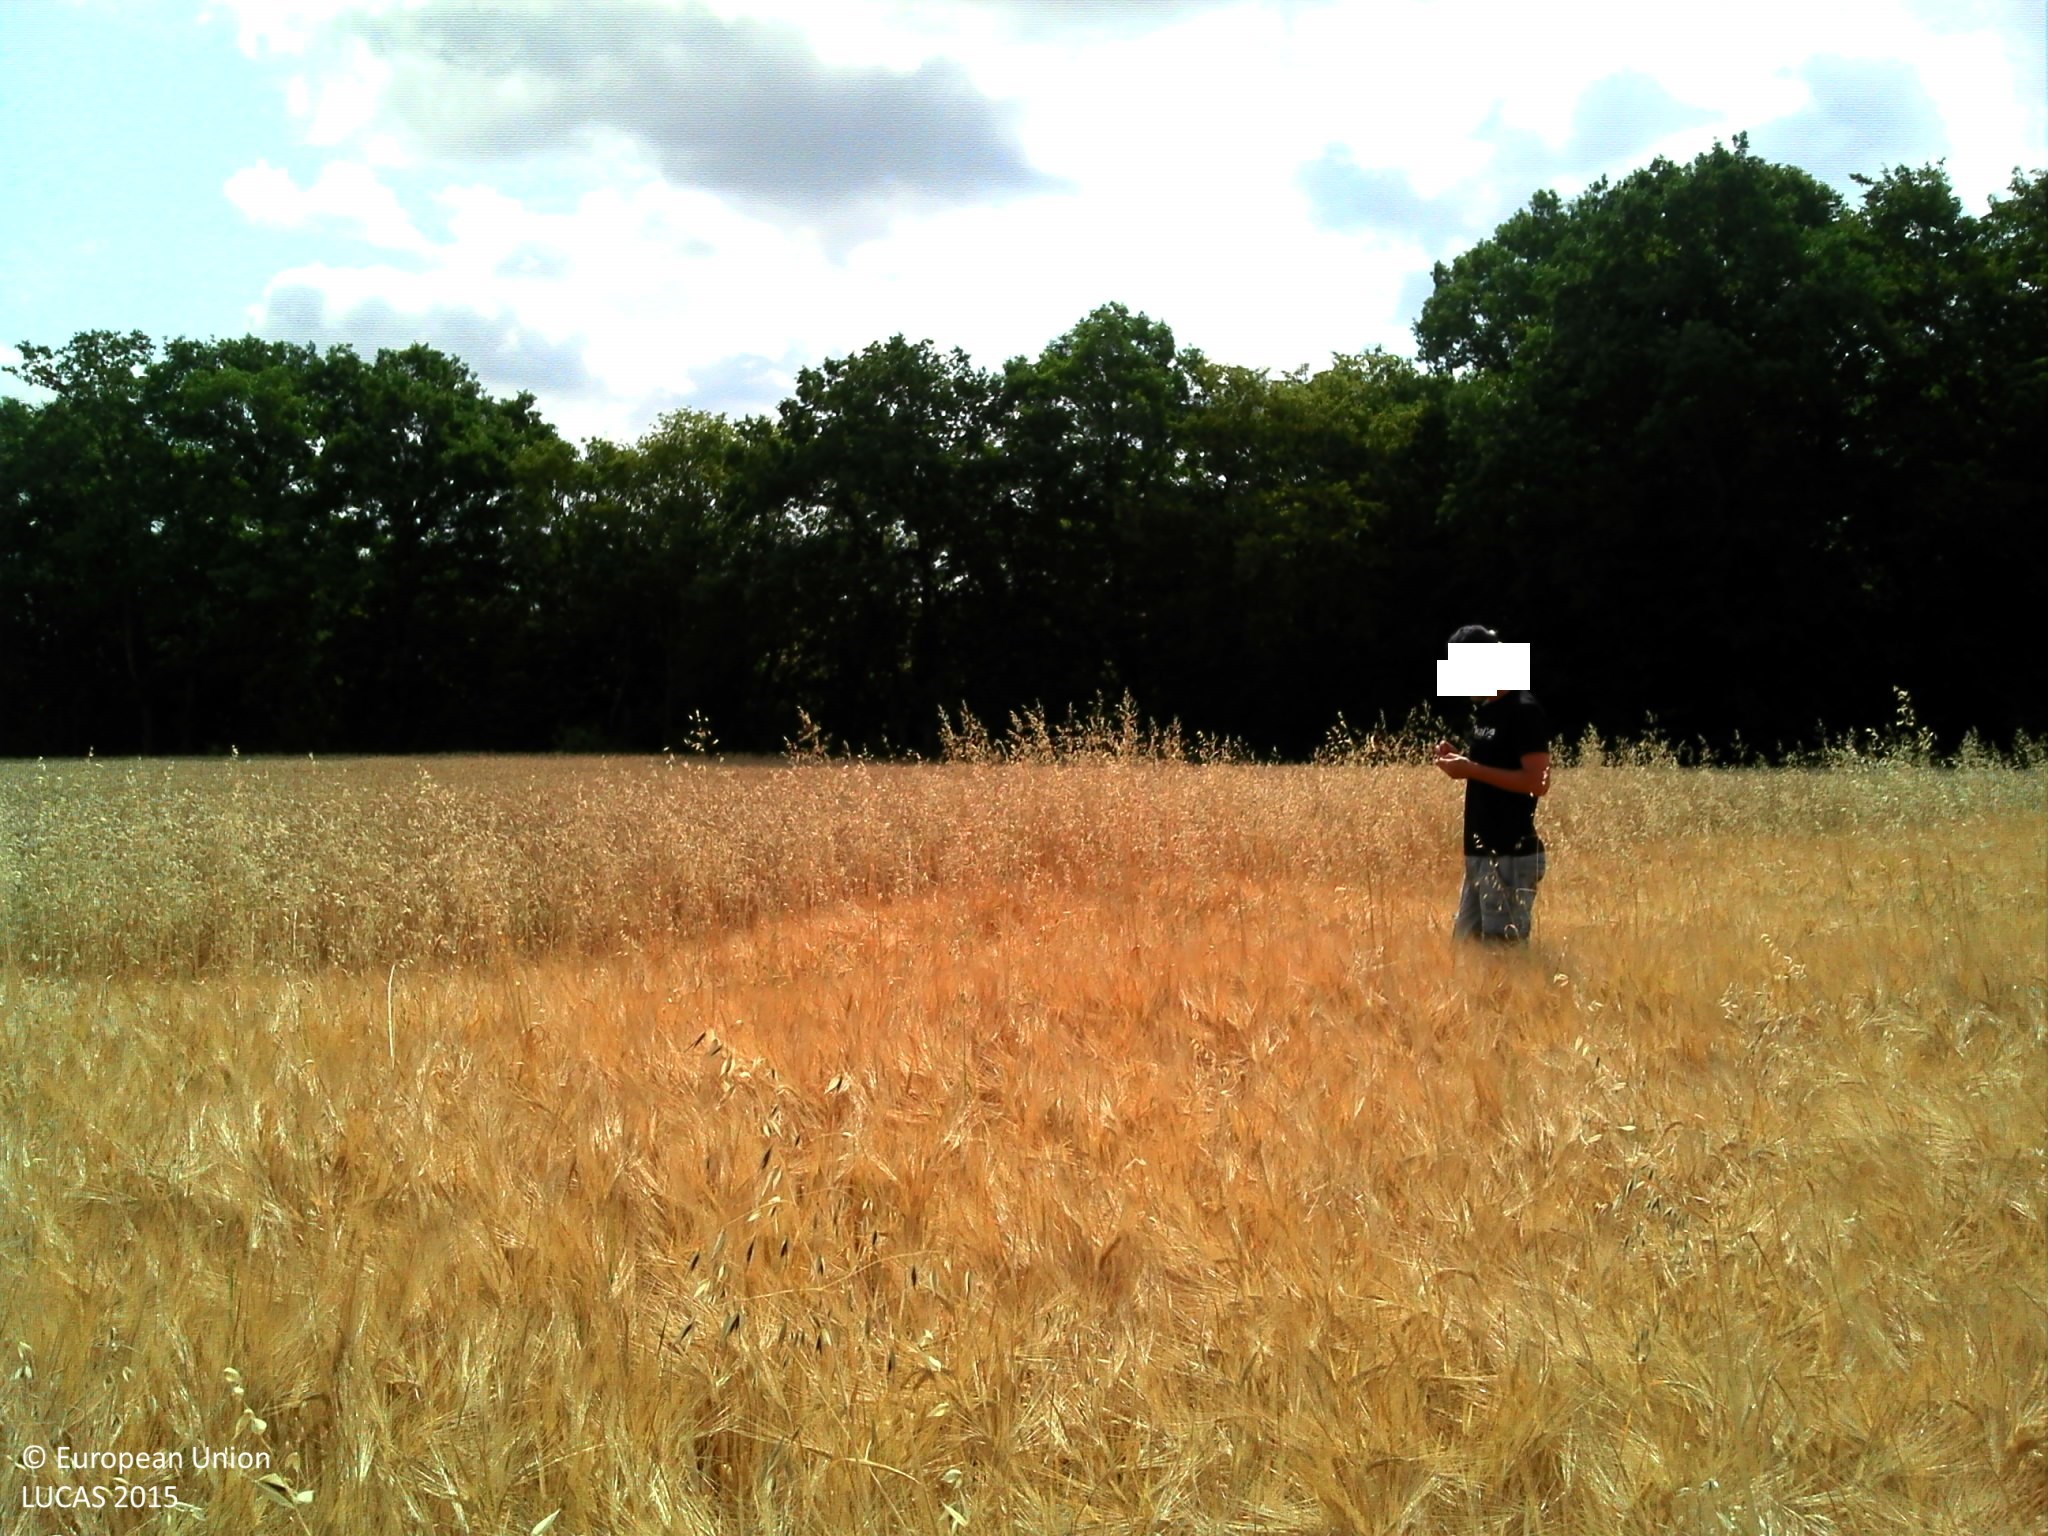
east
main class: Cropland
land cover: Barley
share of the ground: > 75 %
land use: Agriculture (excluding fallow land and kitchen gardens)
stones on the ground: 10 - 25 %
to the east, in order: Barley; Common wheat; Broadleaved woodland; Inland fresh running water; Broadleaved woodland; Tracks; Inland fresh running water; Spontaneously vegetated surfaces; Ditches and canals; Grassland without tree/shrub cover; Tracks
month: July
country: FR
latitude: 48.0306
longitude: 5.2388
